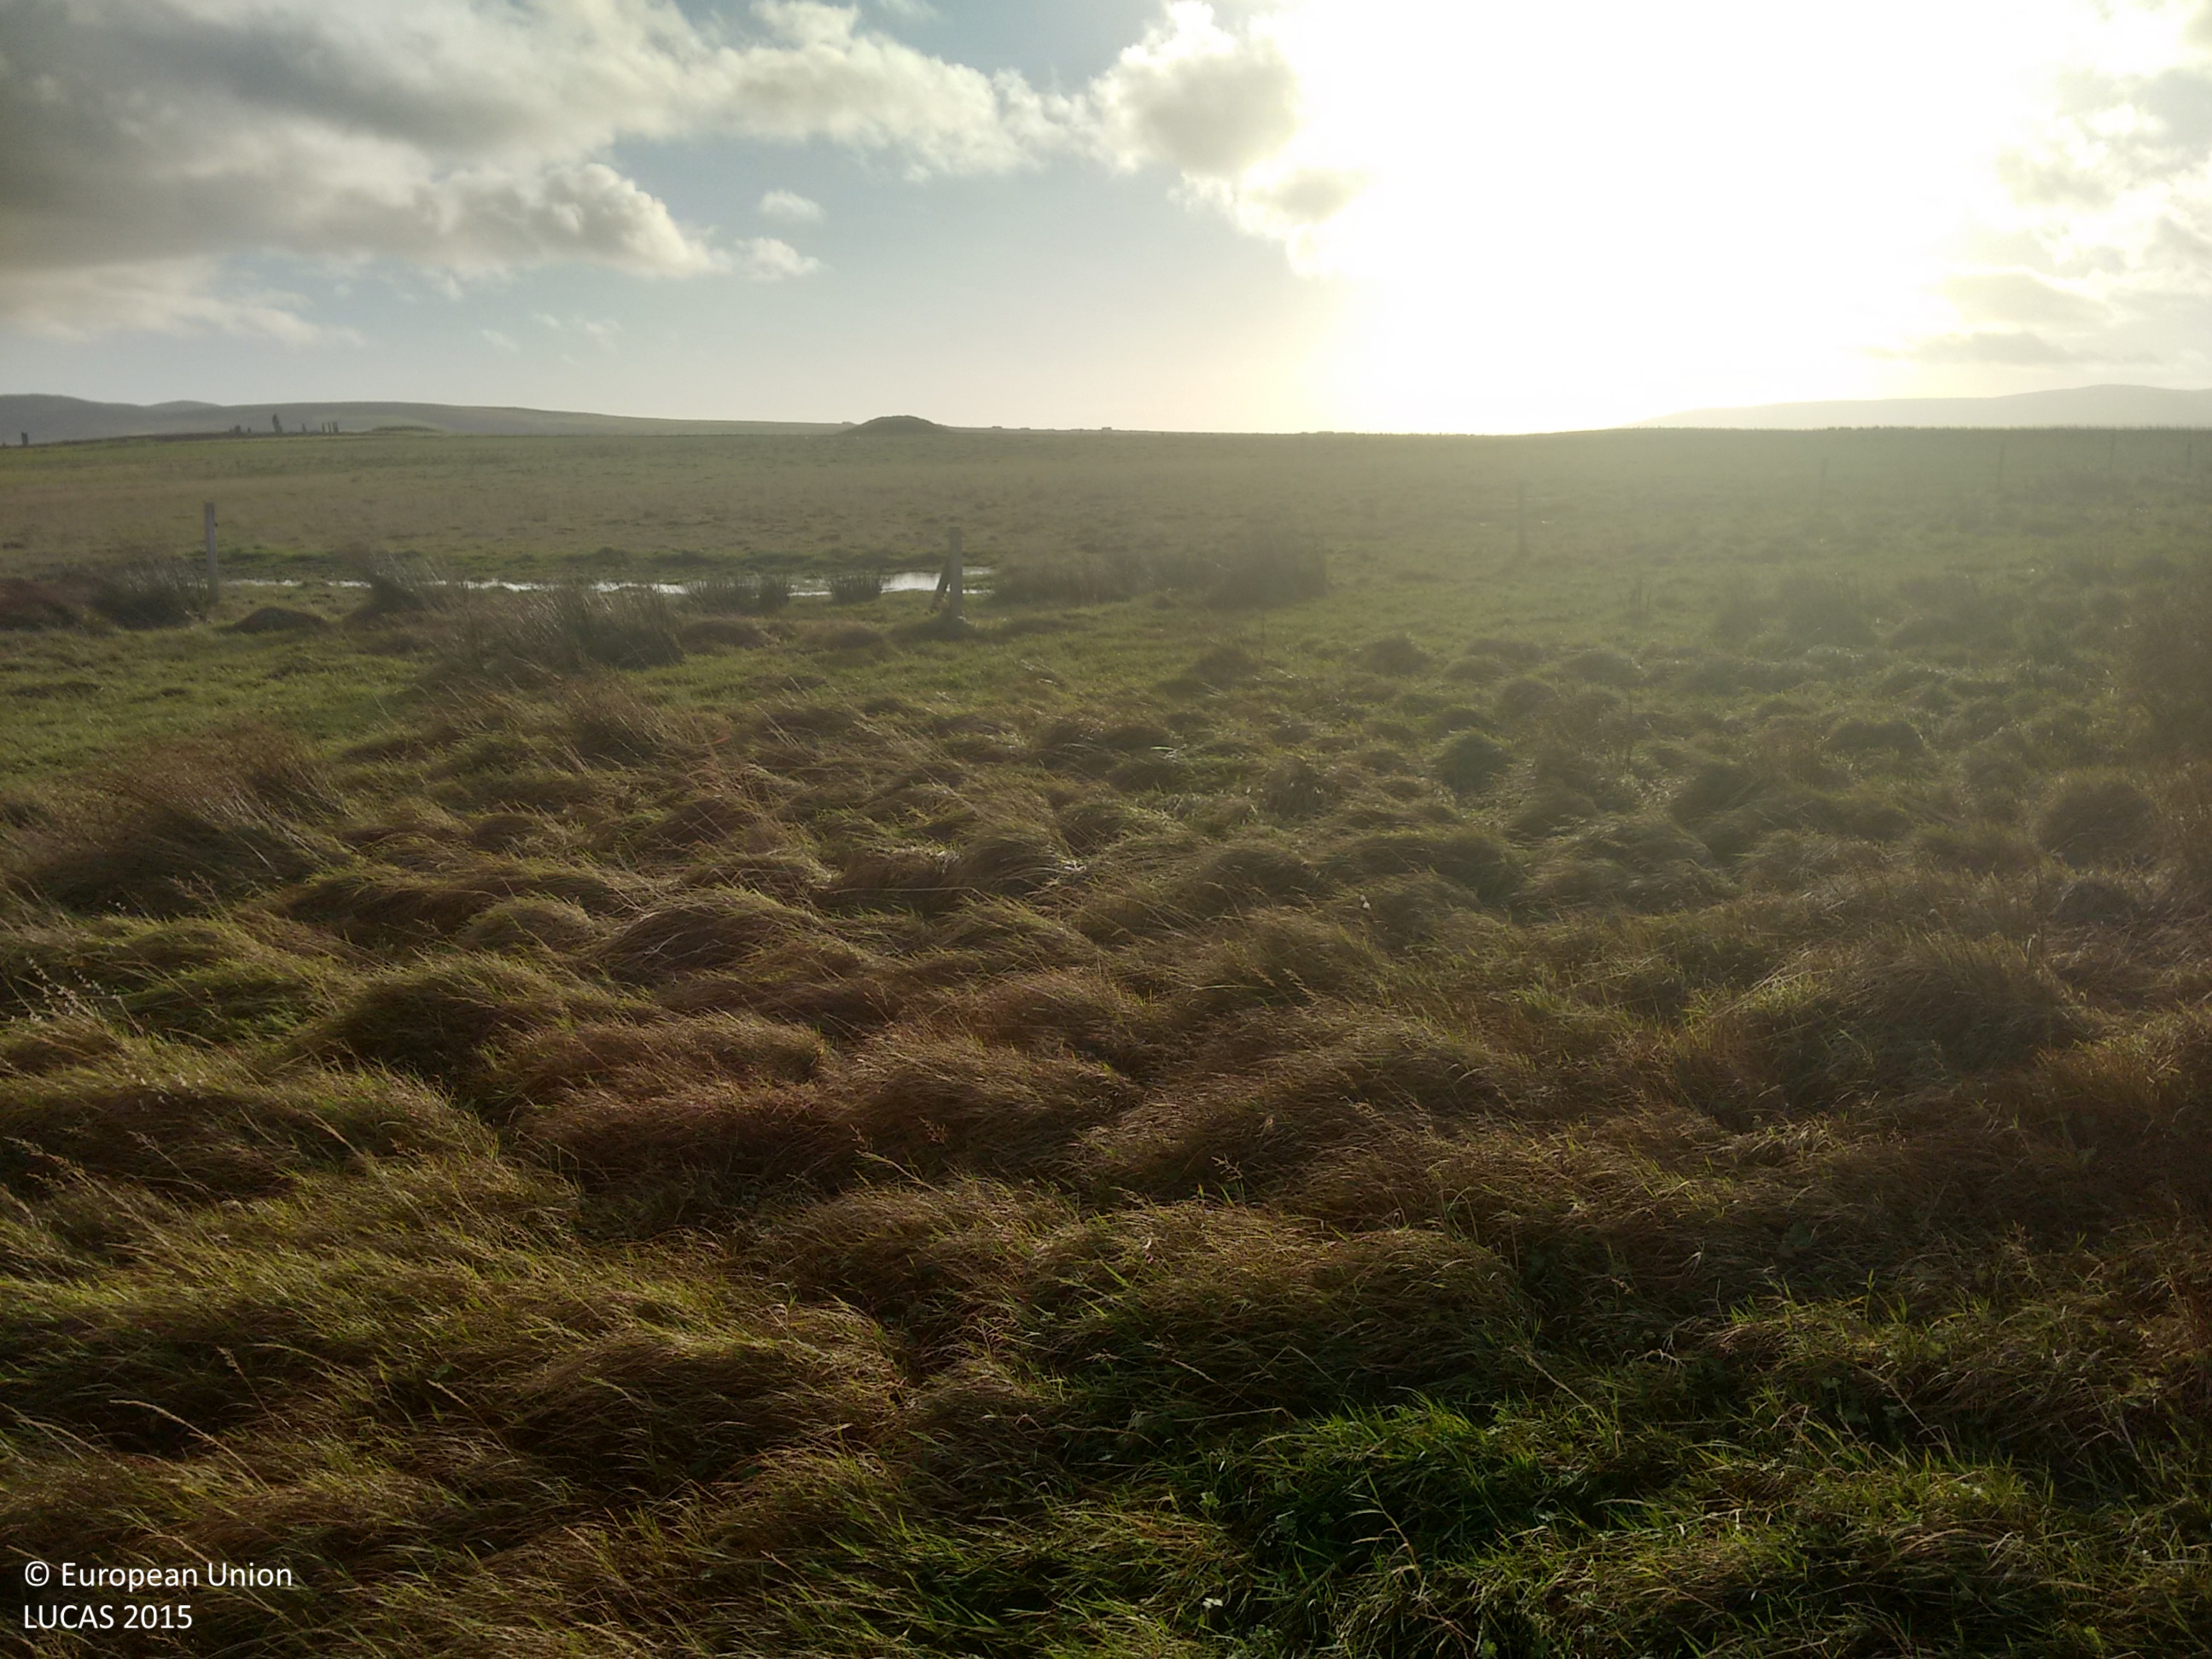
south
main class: Grassland
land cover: Grassland without tree/shrub cover
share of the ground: > 75 %
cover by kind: herbaceous plants 100 %
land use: Agriculture (excluding fallow land and kitchen gardens)
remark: Temporary flooded
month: November
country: GB
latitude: 59.0046
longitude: -3.2357
